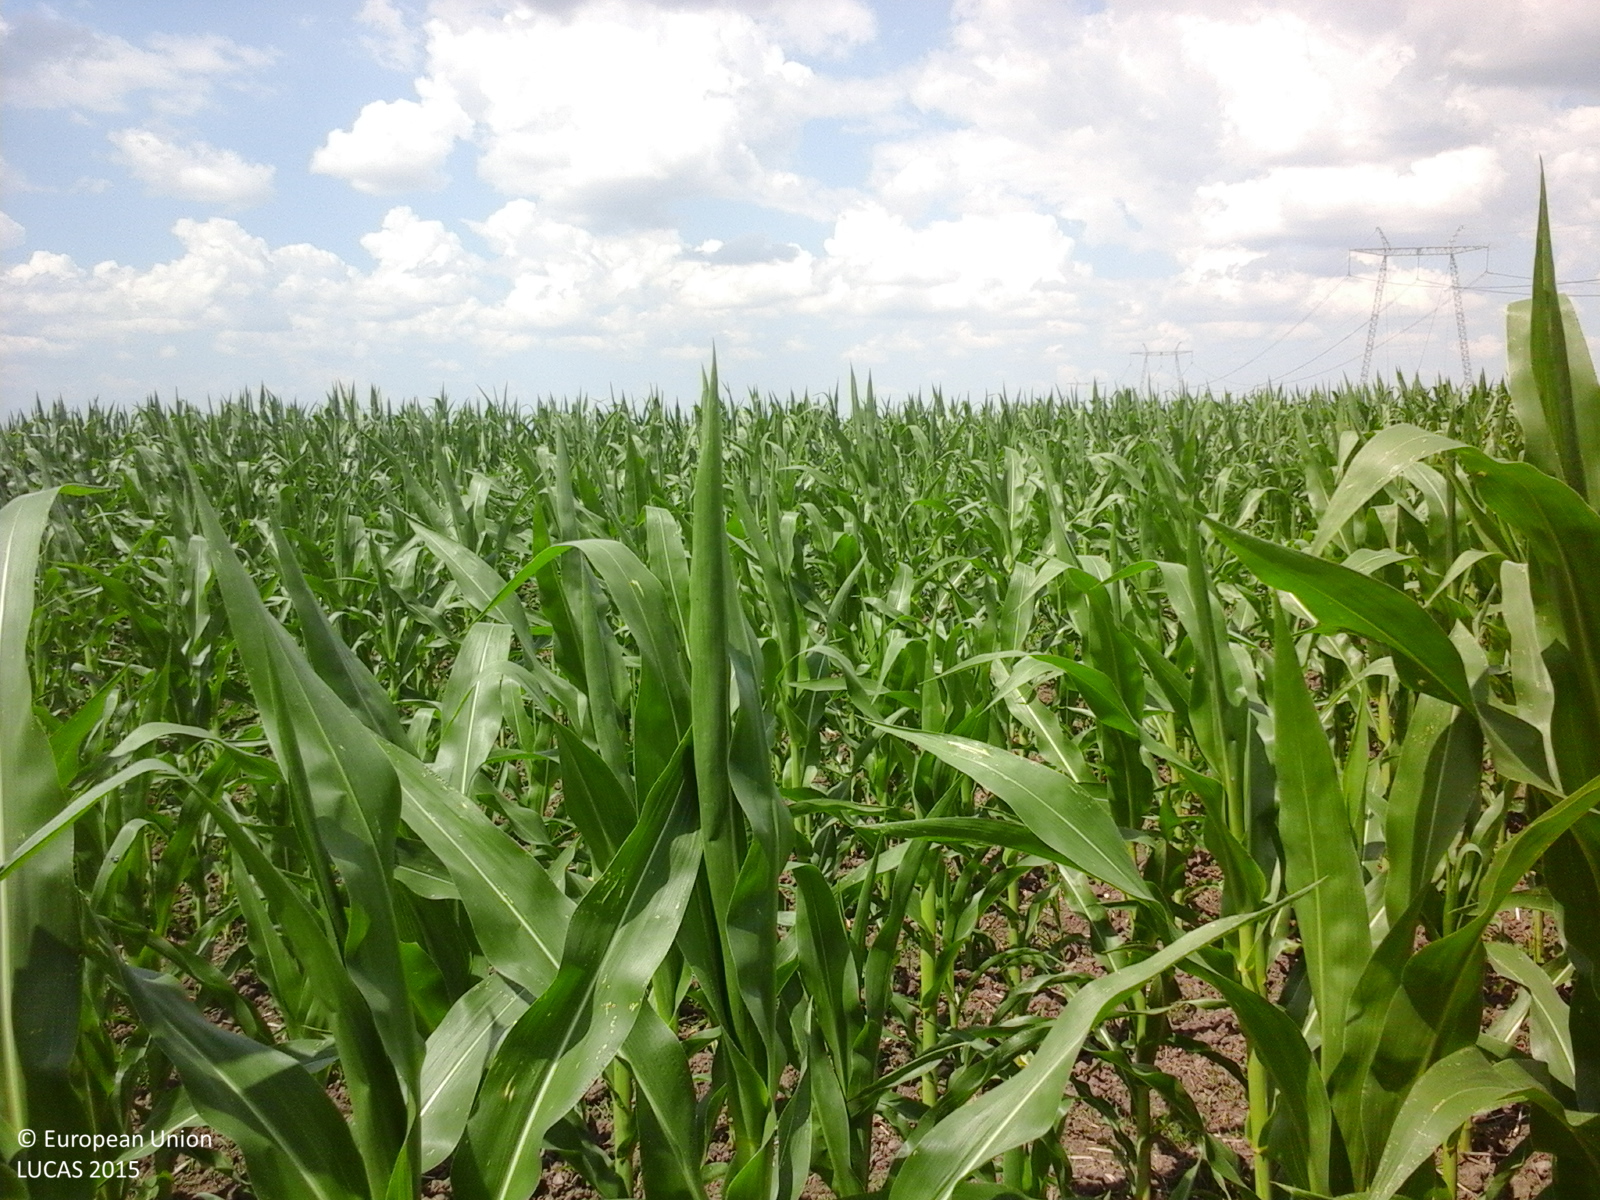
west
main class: Cropland
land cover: Maize
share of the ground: > 75 %
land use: Agriculture (excluding fallow land and kitchen gardens)
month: July
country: RO
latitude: 44.2554
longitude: 25.4050
